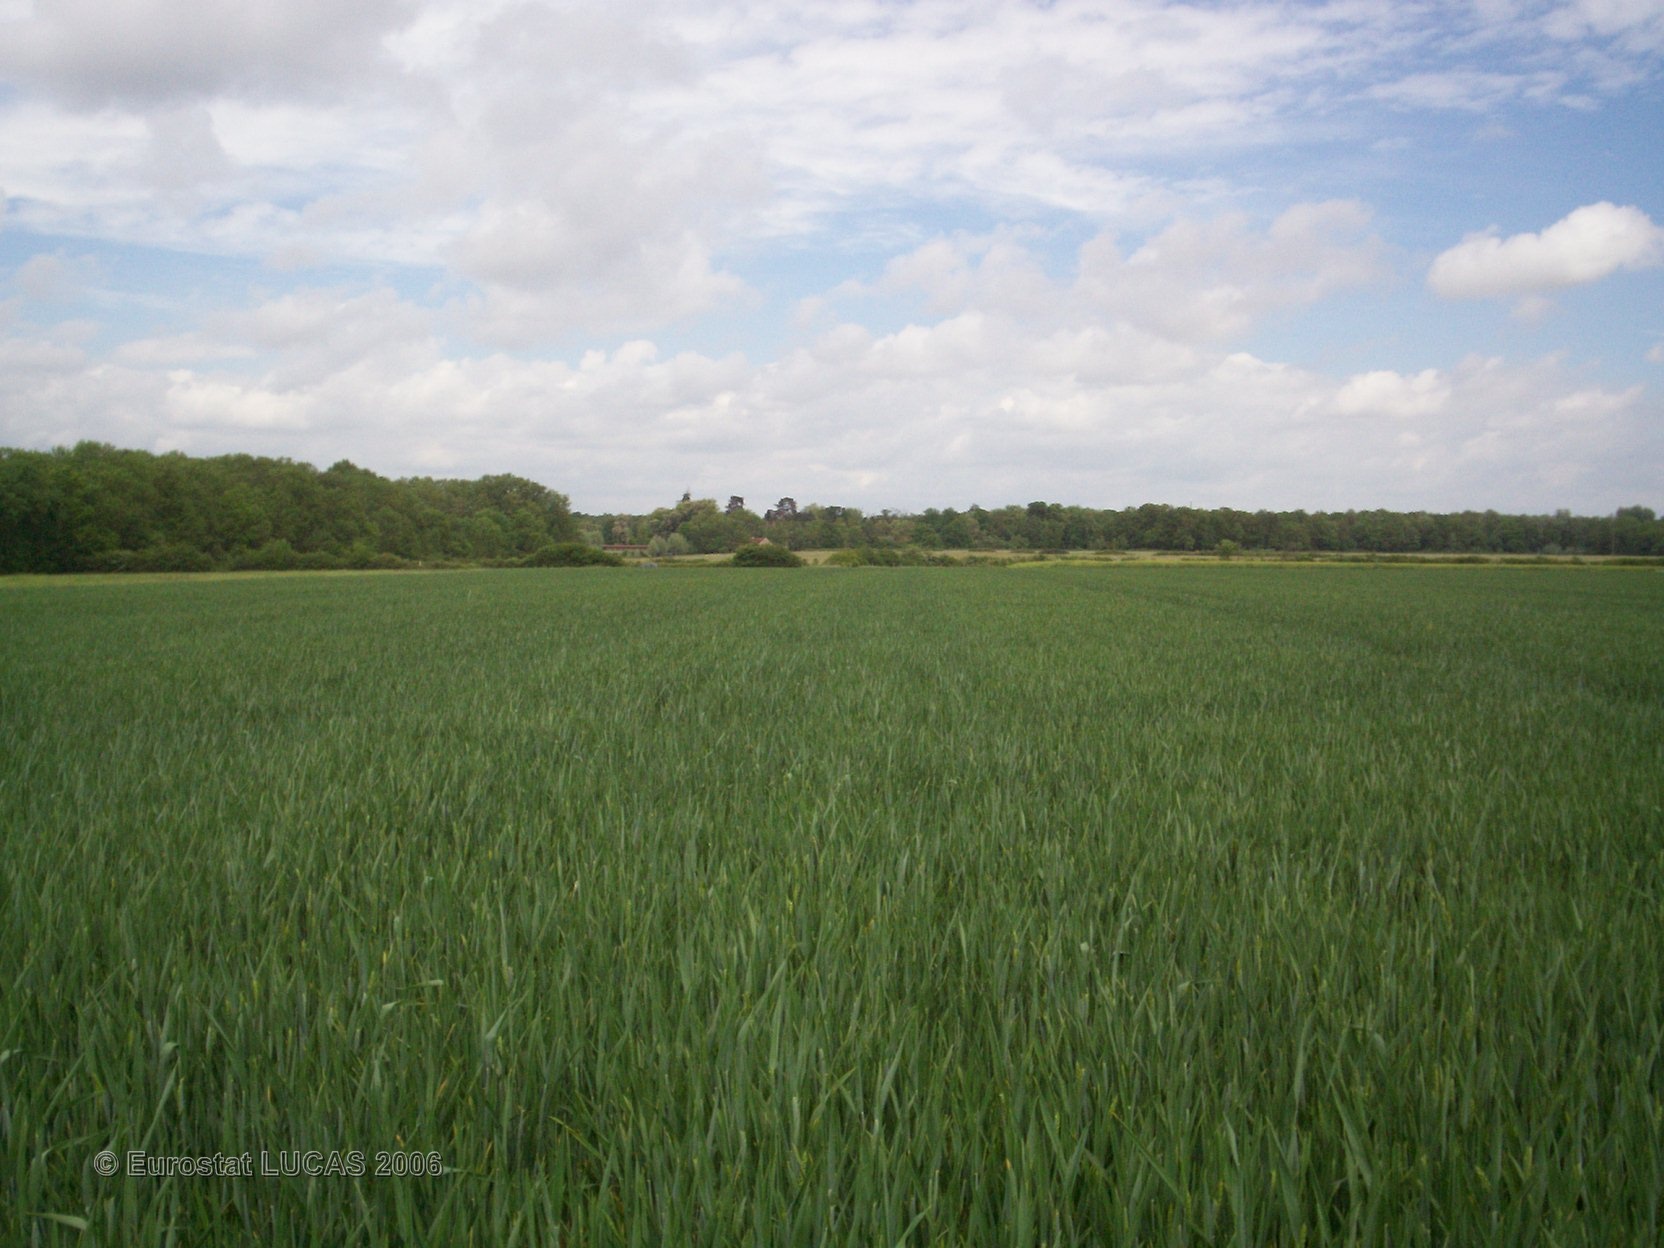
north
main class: Cropland
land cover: Common wheat
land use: Agriculture (excluding fallow land and kitchen gardens)
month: May
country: FR
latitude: 48.6748
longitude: 2.8066
